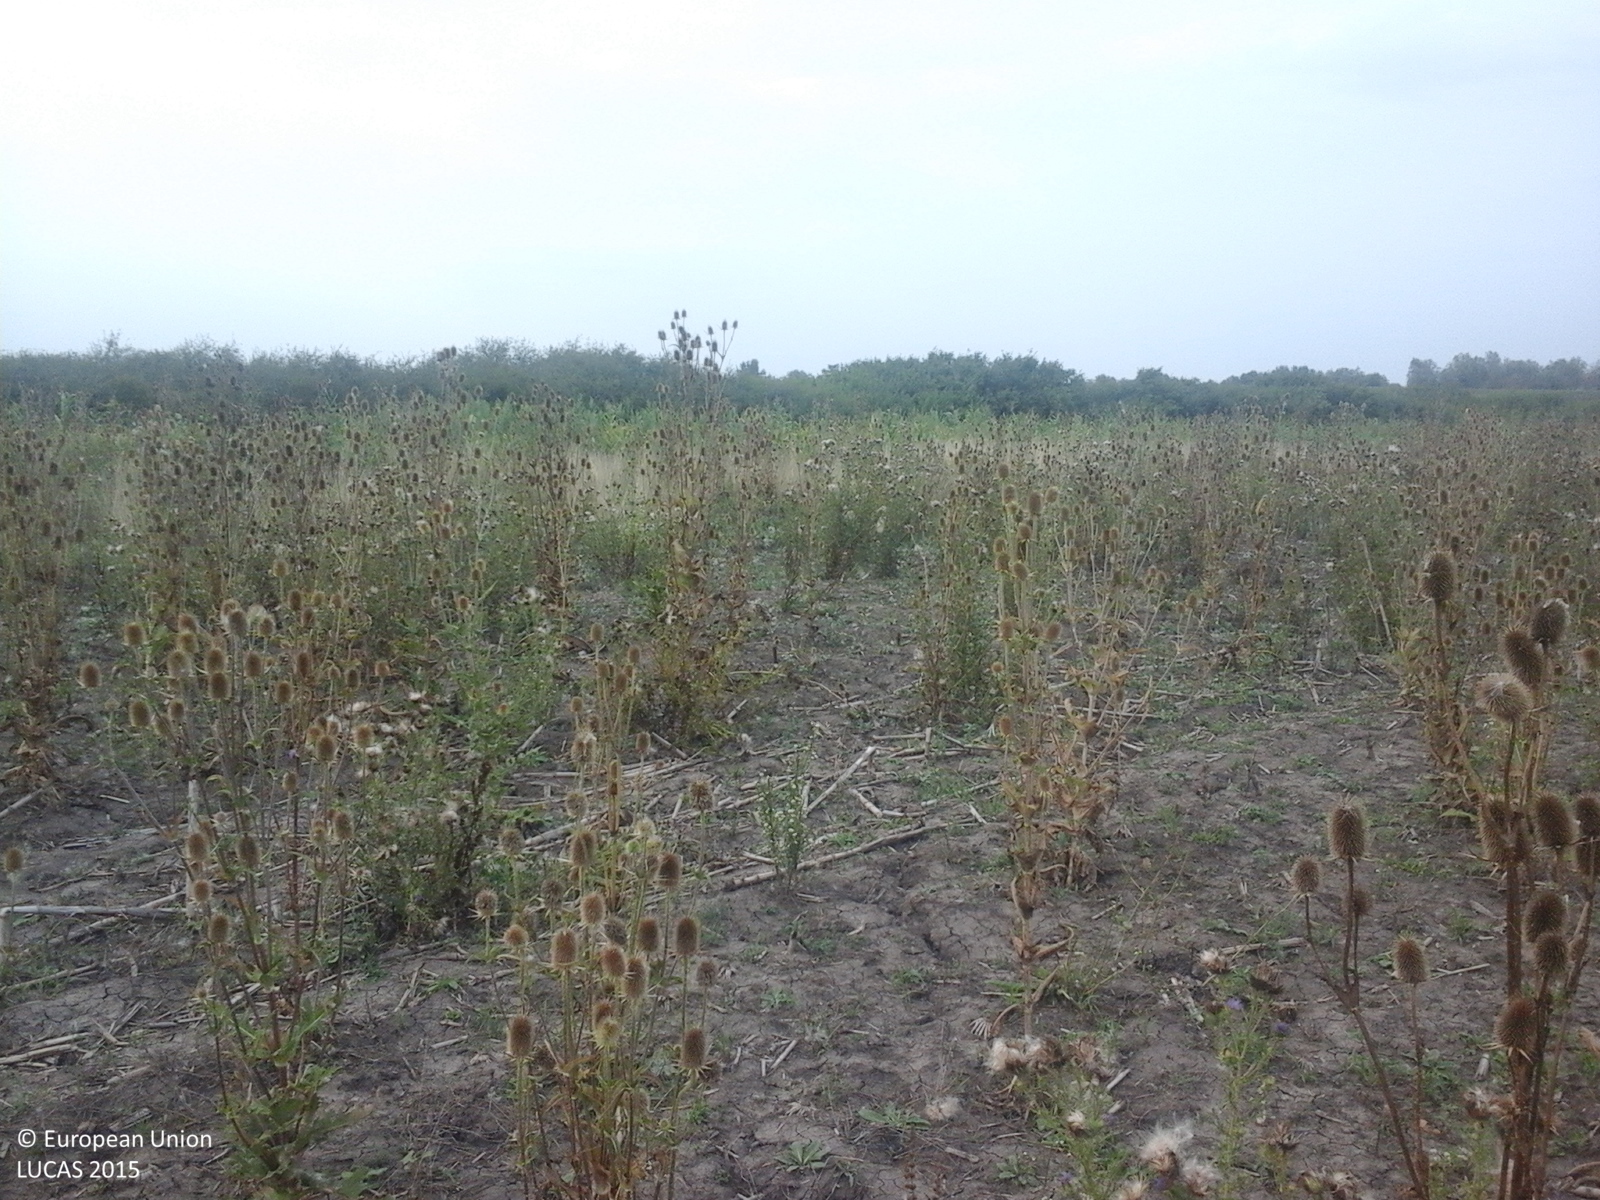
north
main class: Grassland
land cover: Spontaneously vegetated surfaces
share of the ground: > 75 %
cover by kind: herbaceous plants 100 %
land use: Fallow land
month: August
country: RO
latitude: 46.4469
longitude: 21.5852
